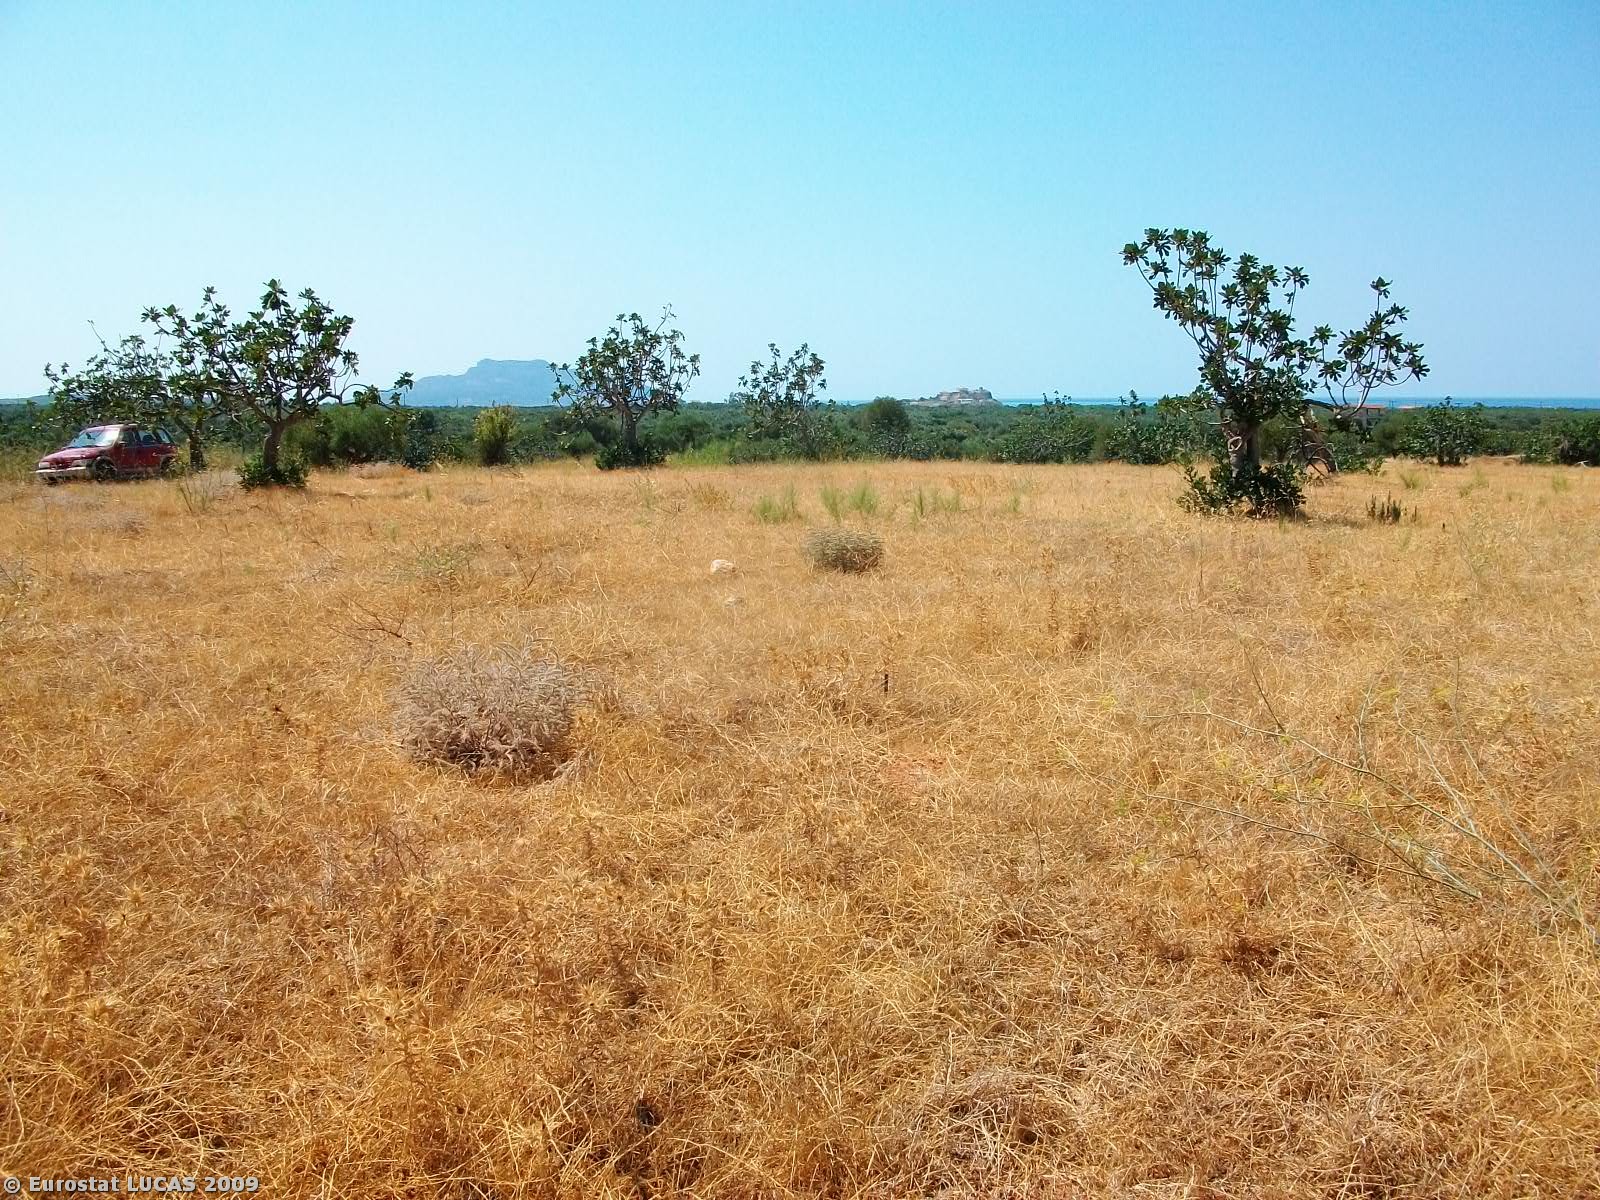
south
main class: Grassland
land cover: Grassland with sparse tree/shrub cover
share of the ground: > 75 %
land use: Agriculture (excluding fallow land and kitchen gardens)
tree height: < 5 m
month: August
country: GR
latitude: 36.7681
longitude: 22.8038
